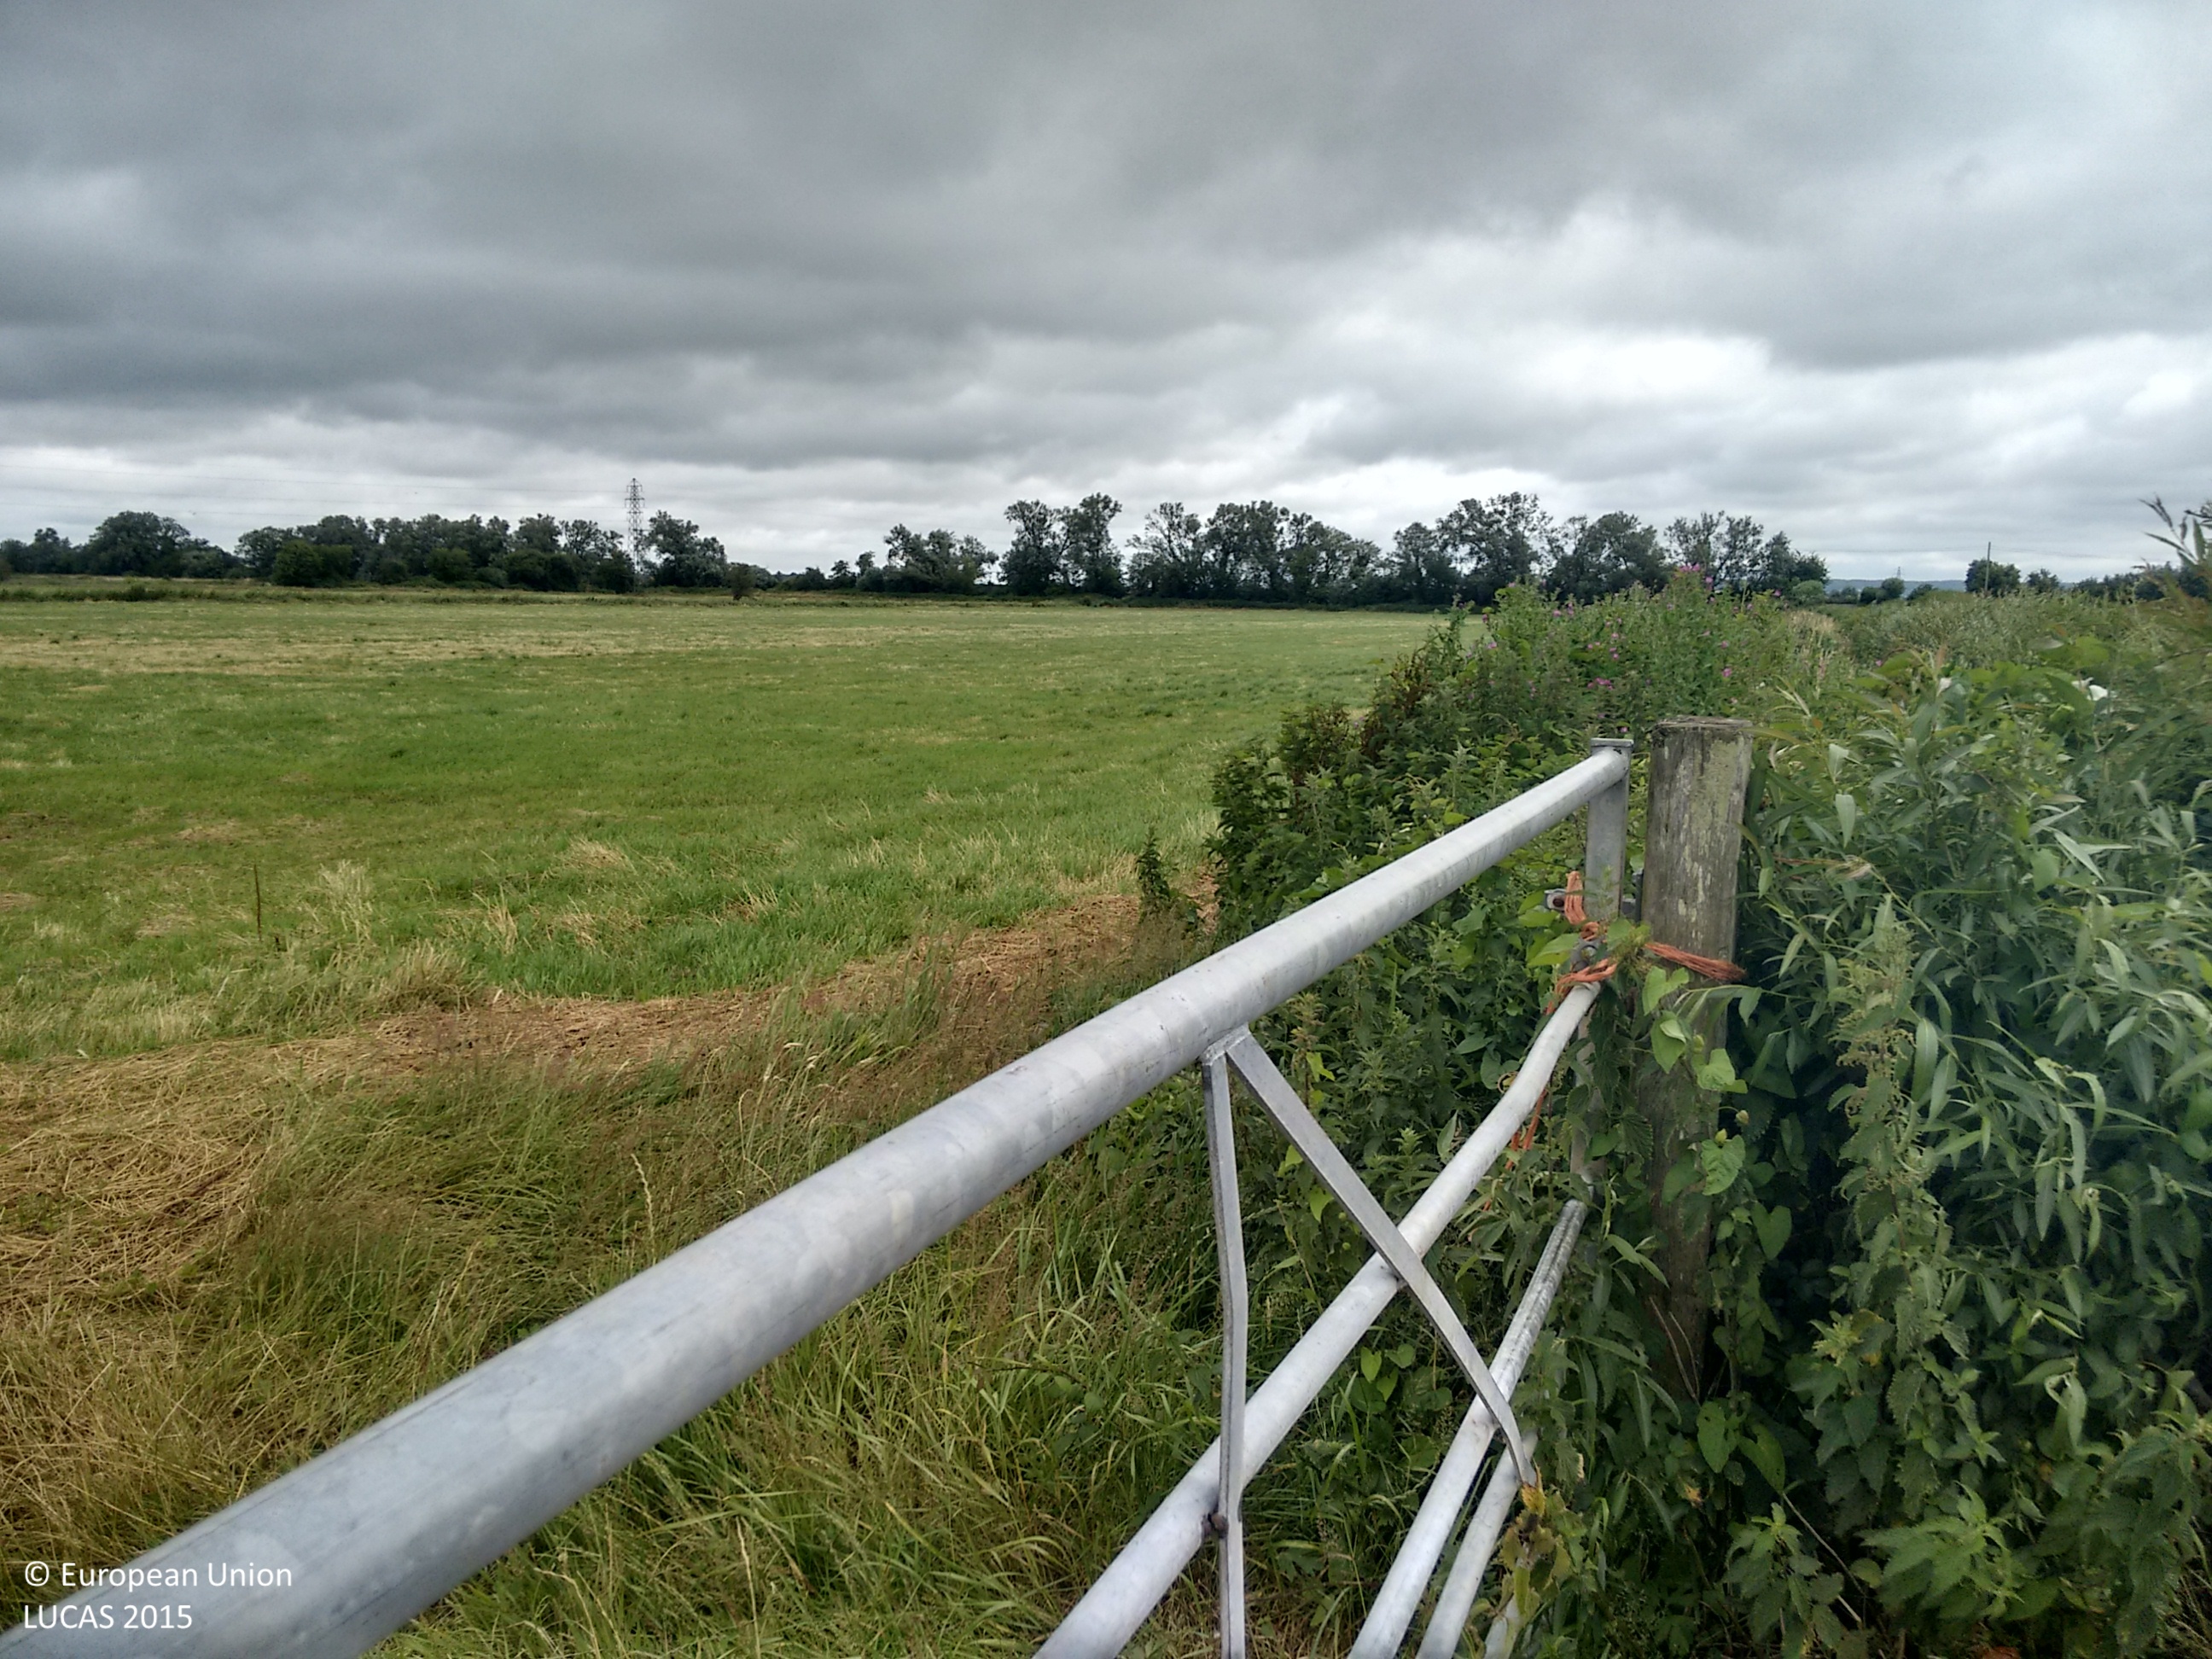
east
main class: Cropland
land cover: Temporary grasslands
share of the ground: > 75 %
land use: Agriculture (excluding fallow land and kitchen gardens)
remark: Harvested field
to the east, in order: Temporary grasslands; Ditches and canals; Temporary grasslands; Electric lines; Temporary grasslands; Inland fresh water bodies; Broadleaved woodland; Electric lines; Broadleaved woodland
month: July
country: GB
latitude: 51.1006
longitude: -2.9408
